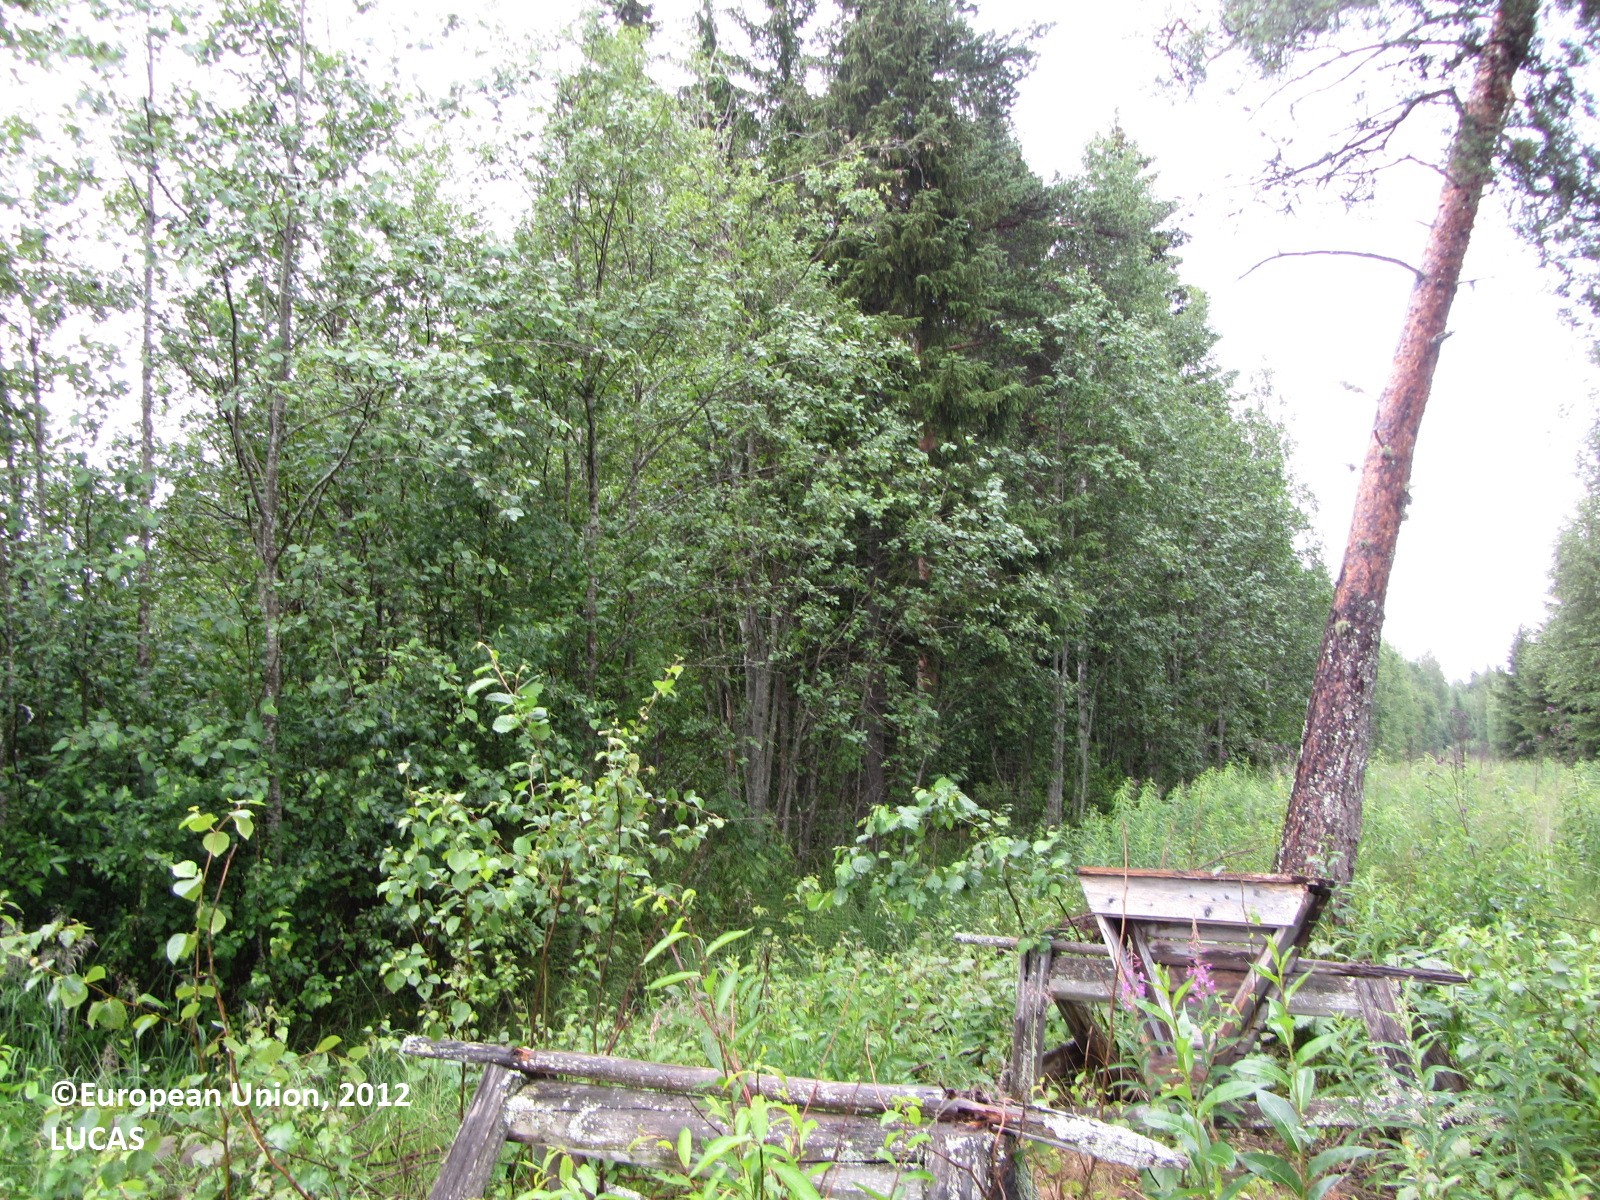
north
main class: Woodland
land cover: Pine dominated coniferous woodland
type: boreal forest
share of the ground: 50 - 75 %
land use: Forestry
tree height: > 5 m
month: July
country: FI
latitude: 63.5893
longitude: 25.3511
